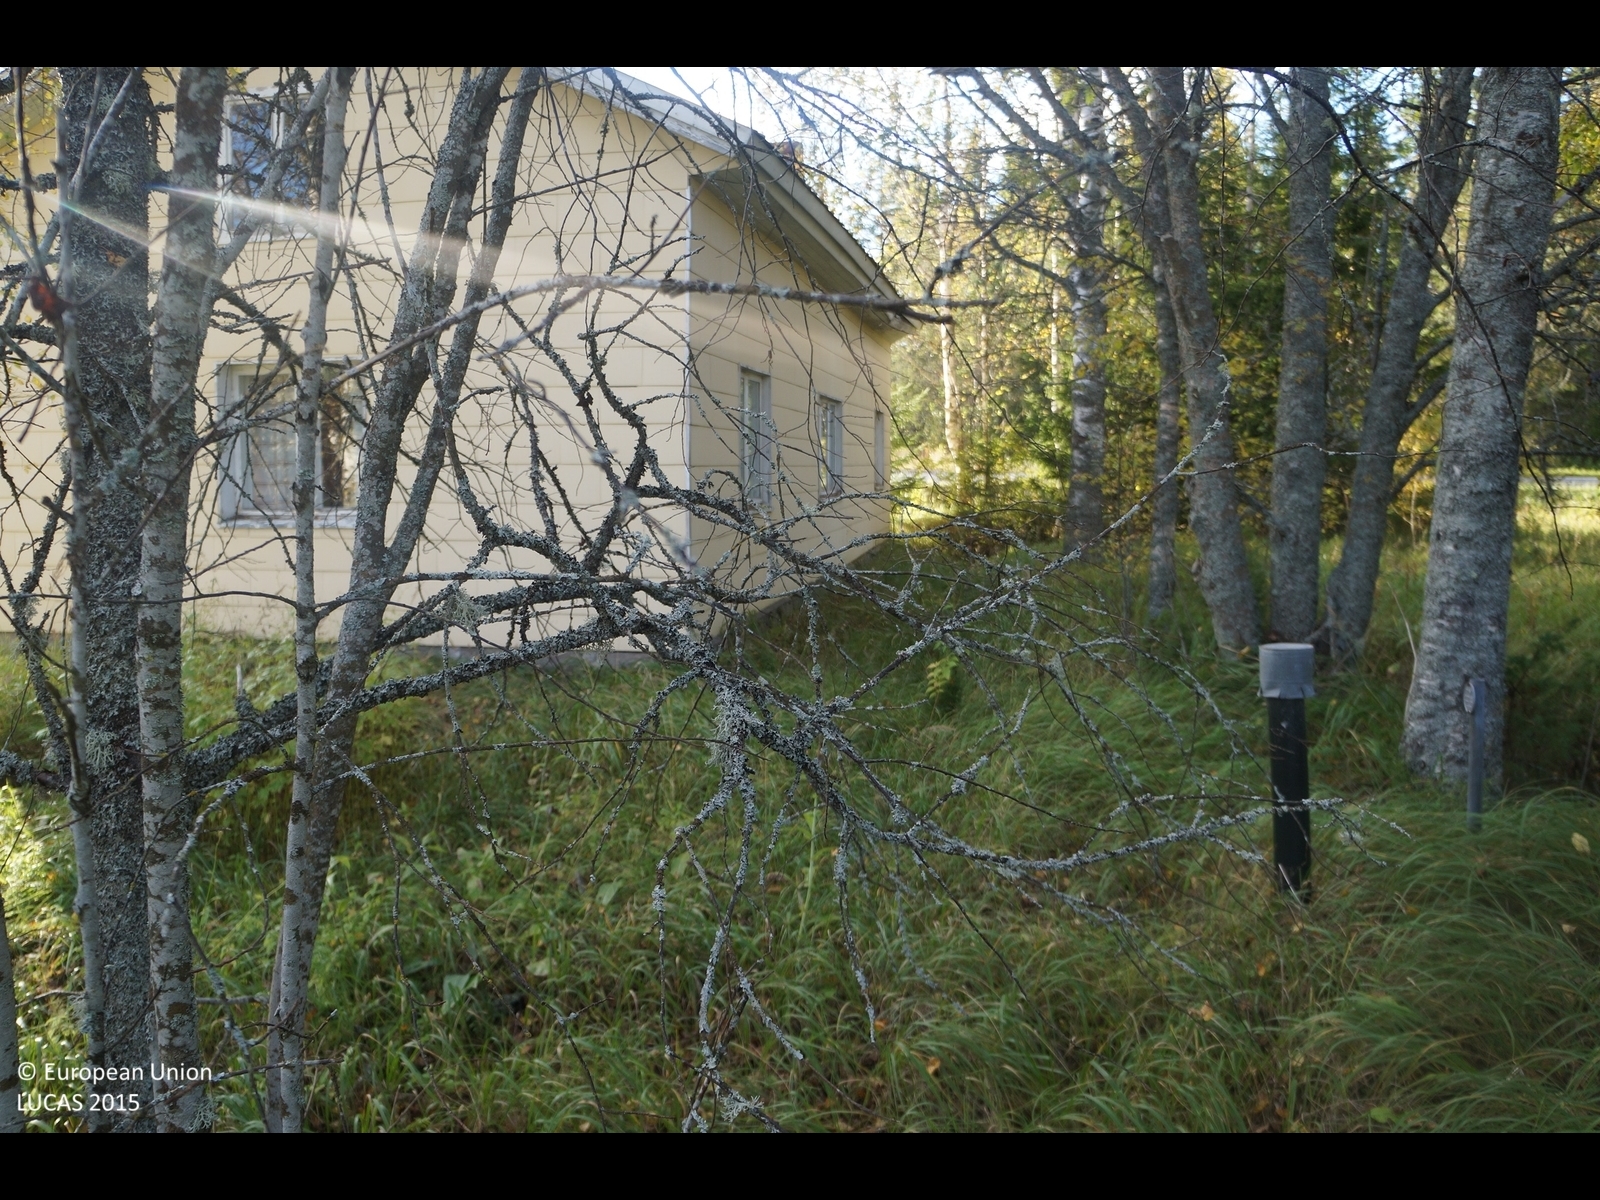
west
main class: Woodland
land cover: Broadleaved woodland
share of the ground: 25 - 50 %
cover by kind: herbaceous plants 65 %, broadleaved forest trees 30 %, coniferous forest trees 5 %
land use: Residential
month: September
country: FI
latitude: 64.2555
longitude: 24.3690
